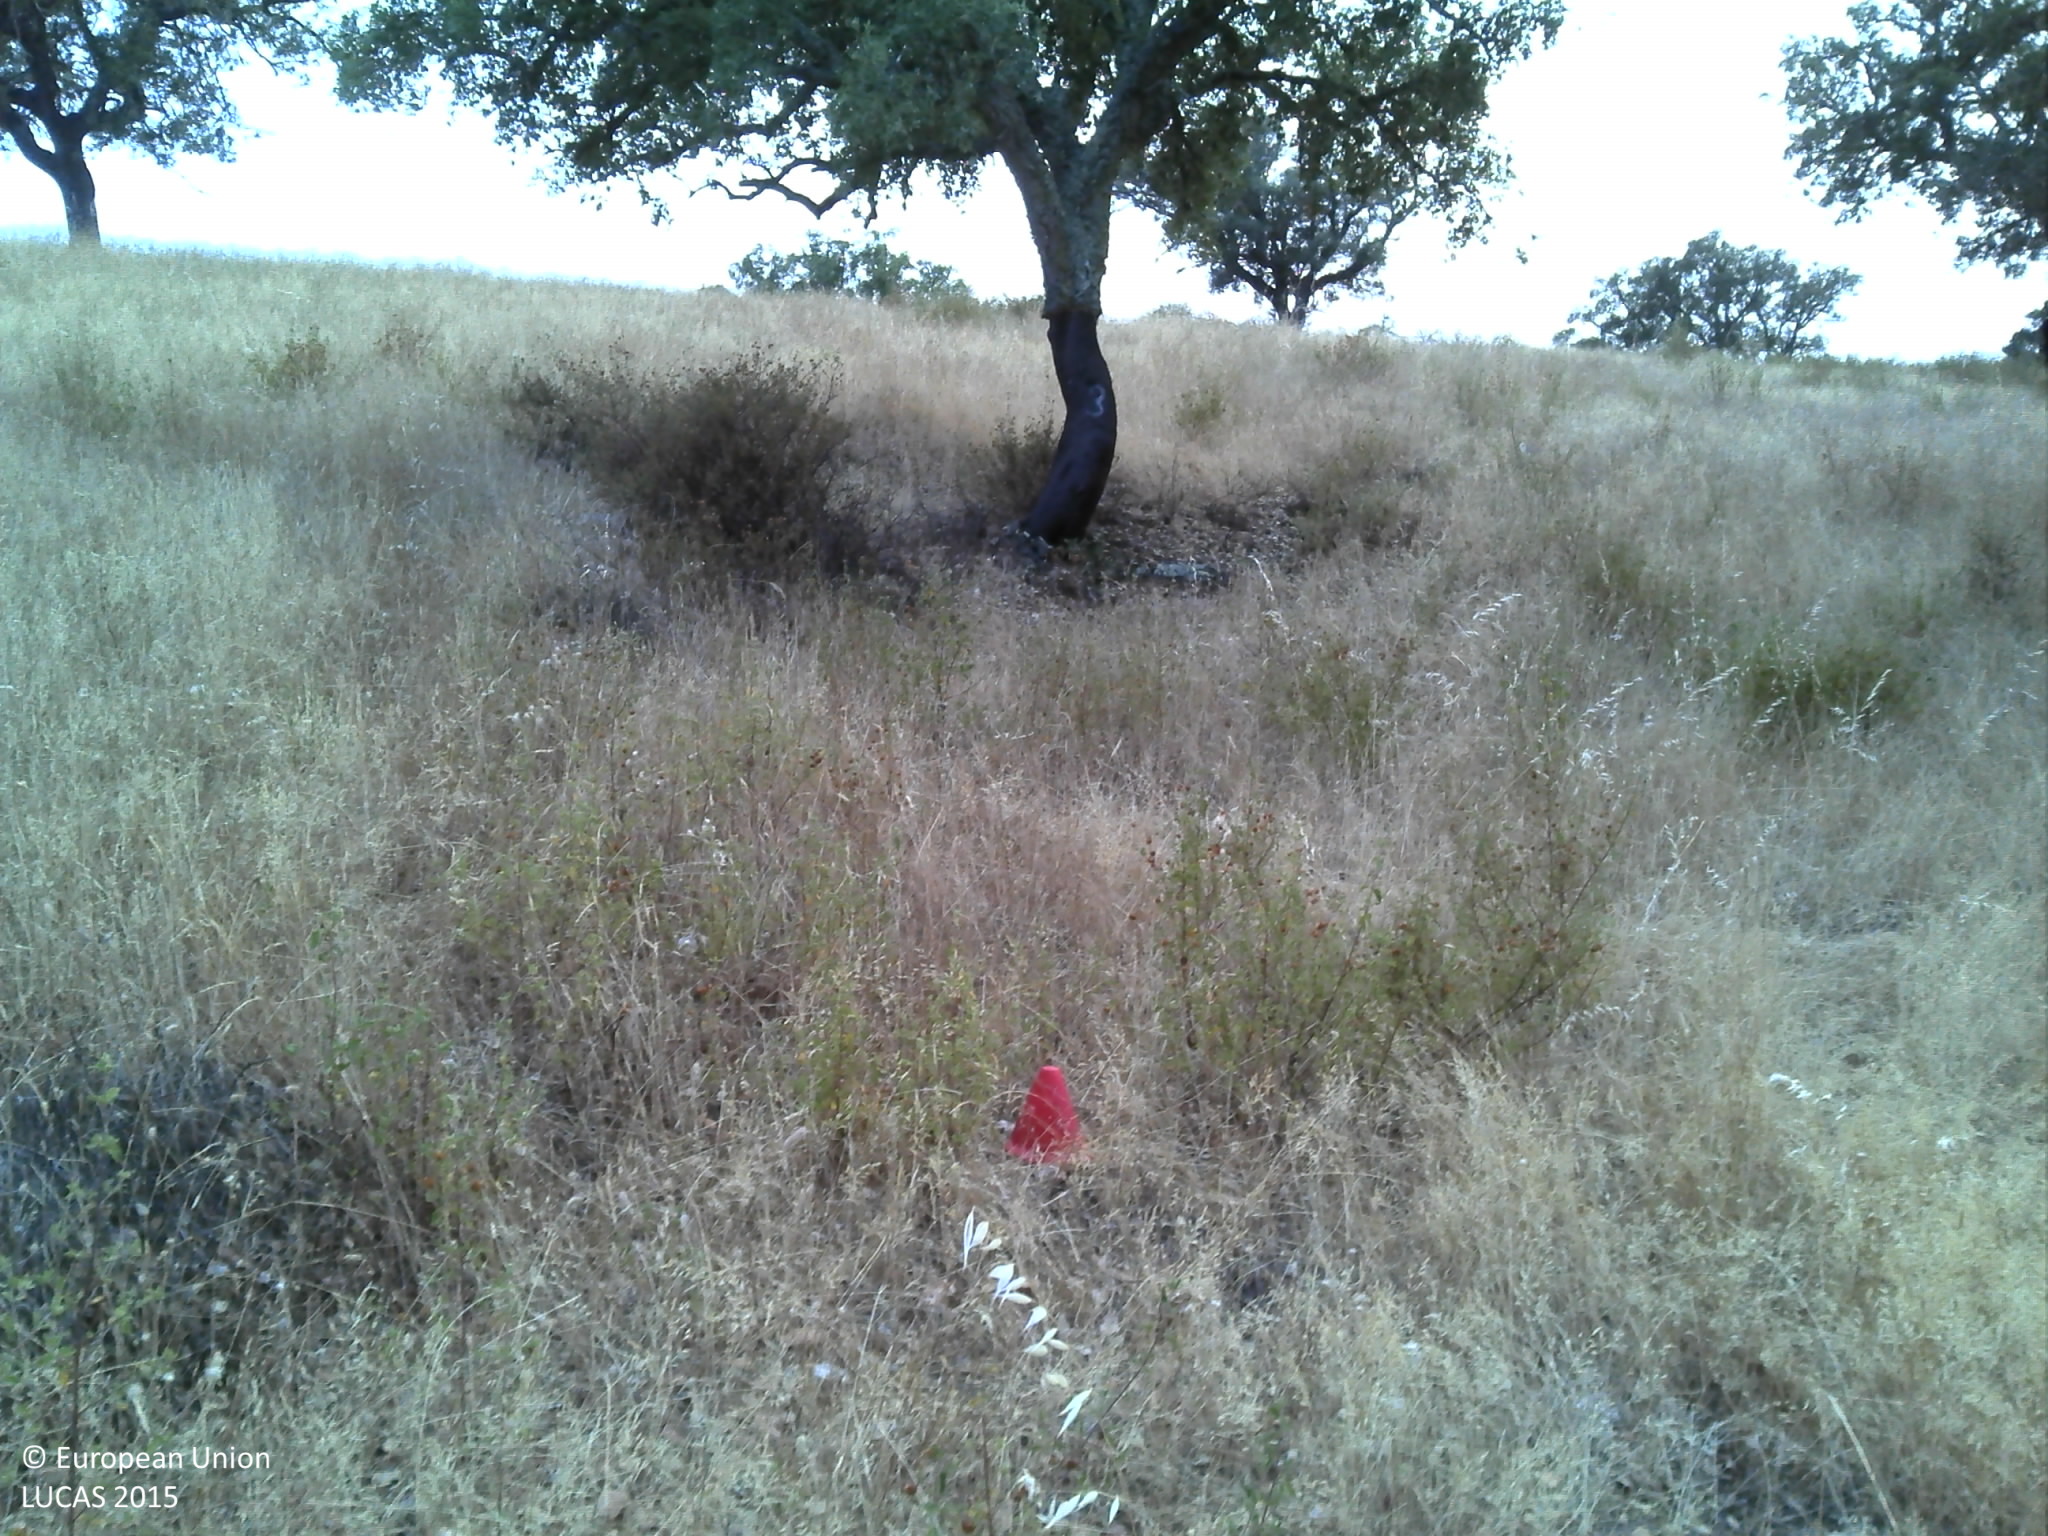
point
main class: Woodland
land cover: Broadleaved woodland
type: broadleaved evergreen forest
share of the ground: 25 - 50 %
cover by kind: herbaceous plants 50 %, broadleaved forest trees 45 %, unconsolidated bare surface 5 %
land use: Forestry
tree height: > 5 m
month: June
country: PT
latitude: 37.8398
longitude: -7.5506
